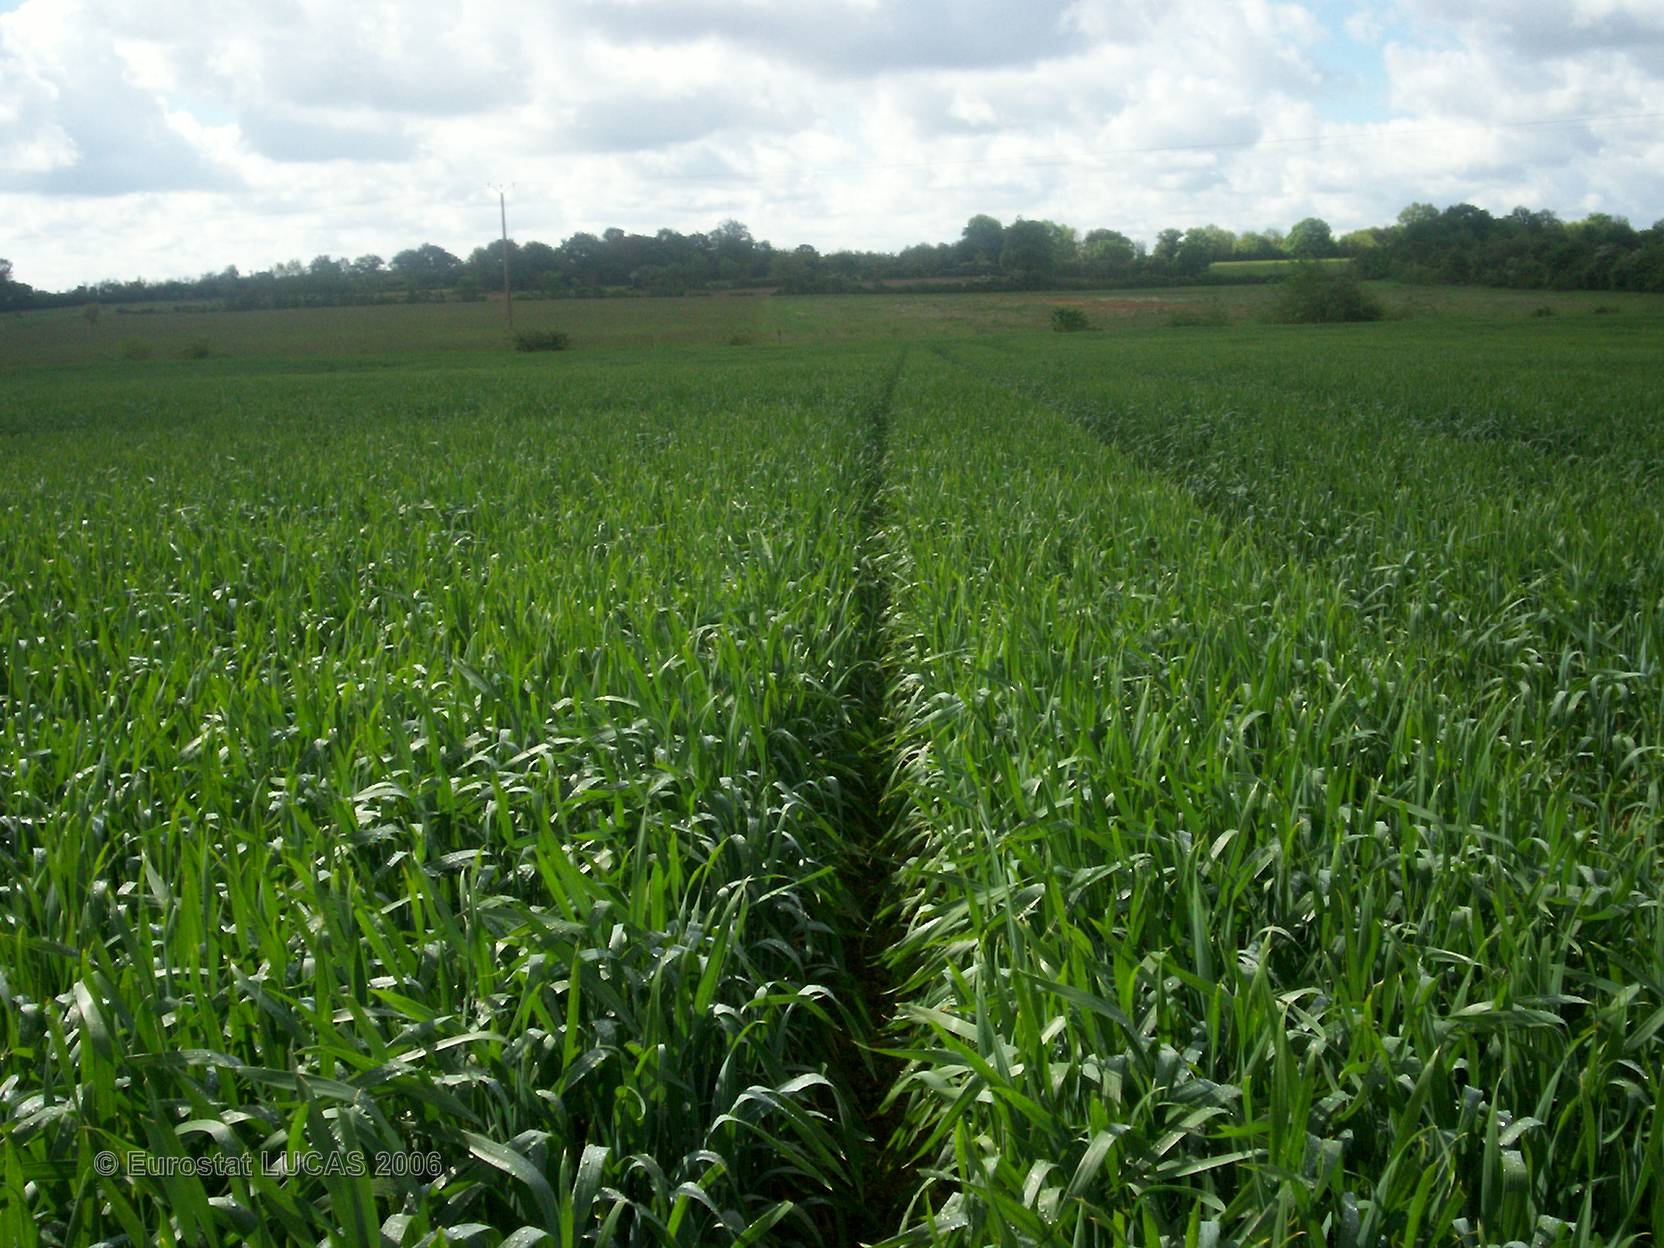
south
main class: Cropland
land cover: Common wheat
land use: Agriculture (excluding fallow land and kitchen gardens)
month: May
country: FR
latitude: 46.3455
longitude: 0.5110
